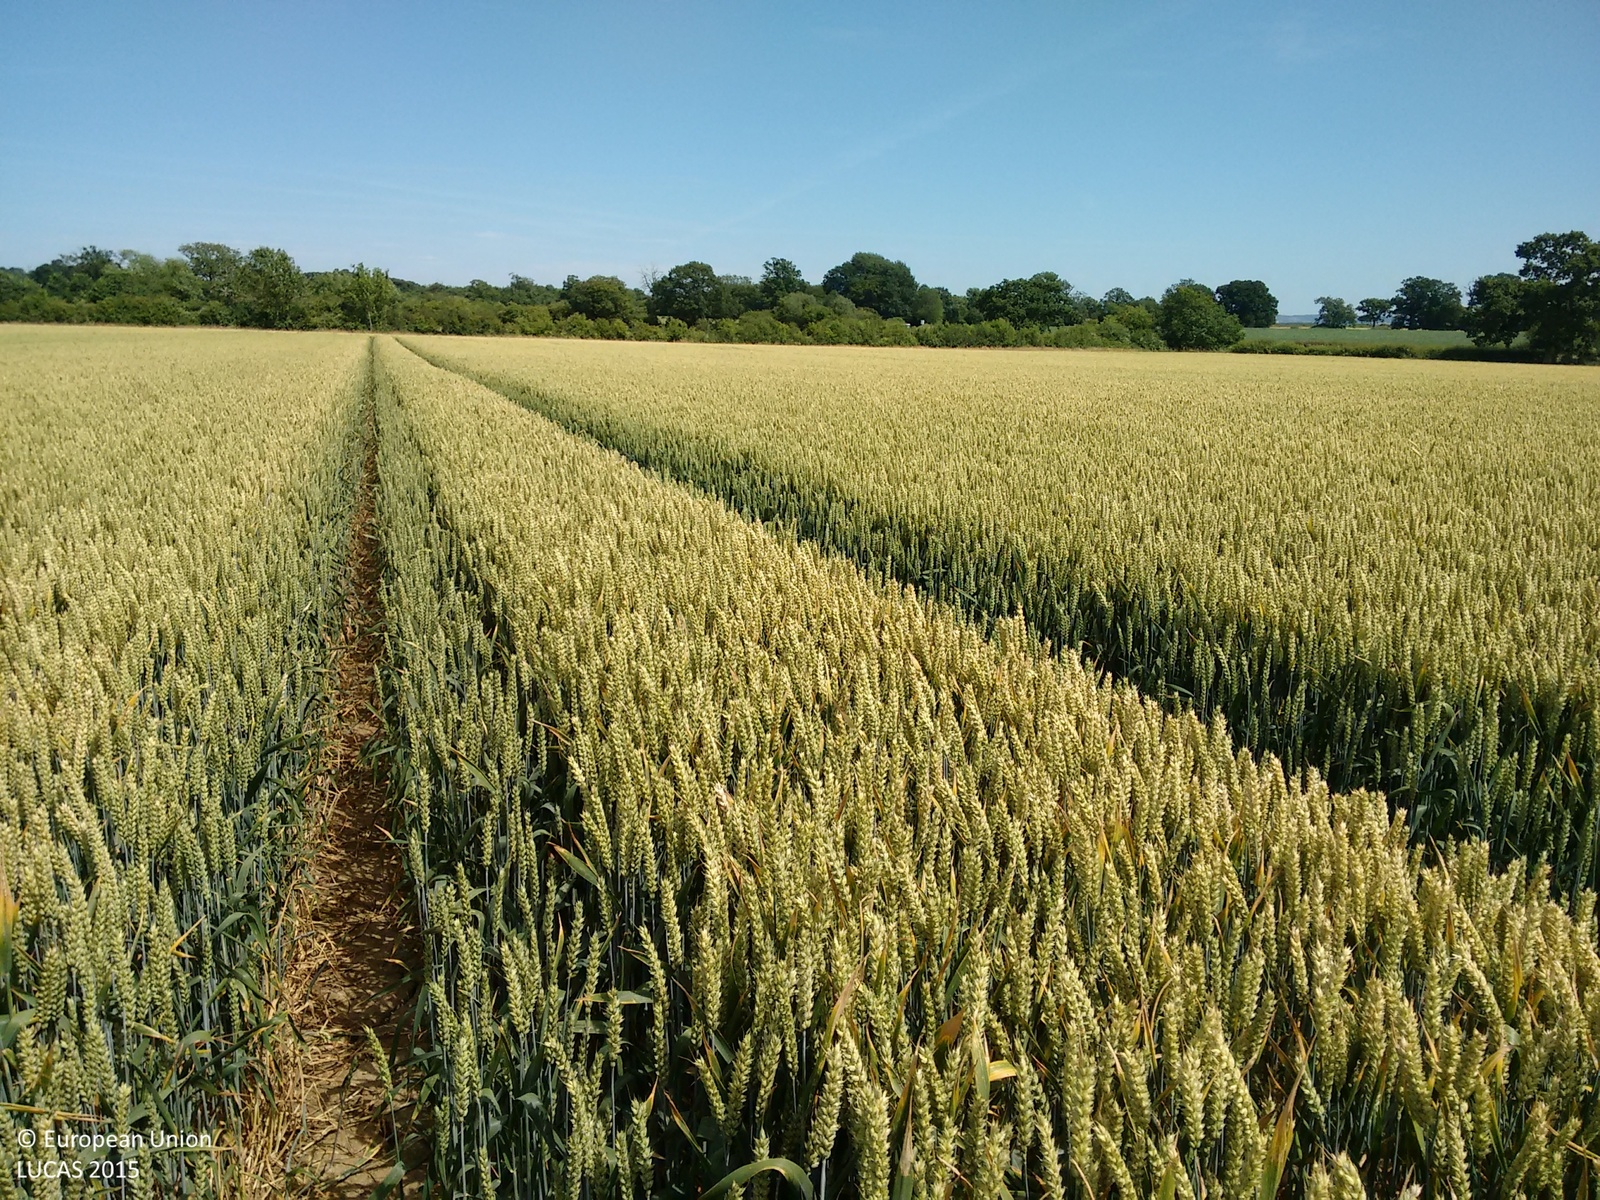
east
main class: Cropland
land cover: Common wheat
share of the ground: > 75 %
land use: Agriculture (excluding fallow land and kitchen gardens)
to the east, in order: Common wheat; Grass margins; Managed hedges; Grass margins; Common wheat; Grassland without tree/shrub cover; Abandoned hedges
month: July
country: GB
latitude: 51.6851
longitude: -1.1697
